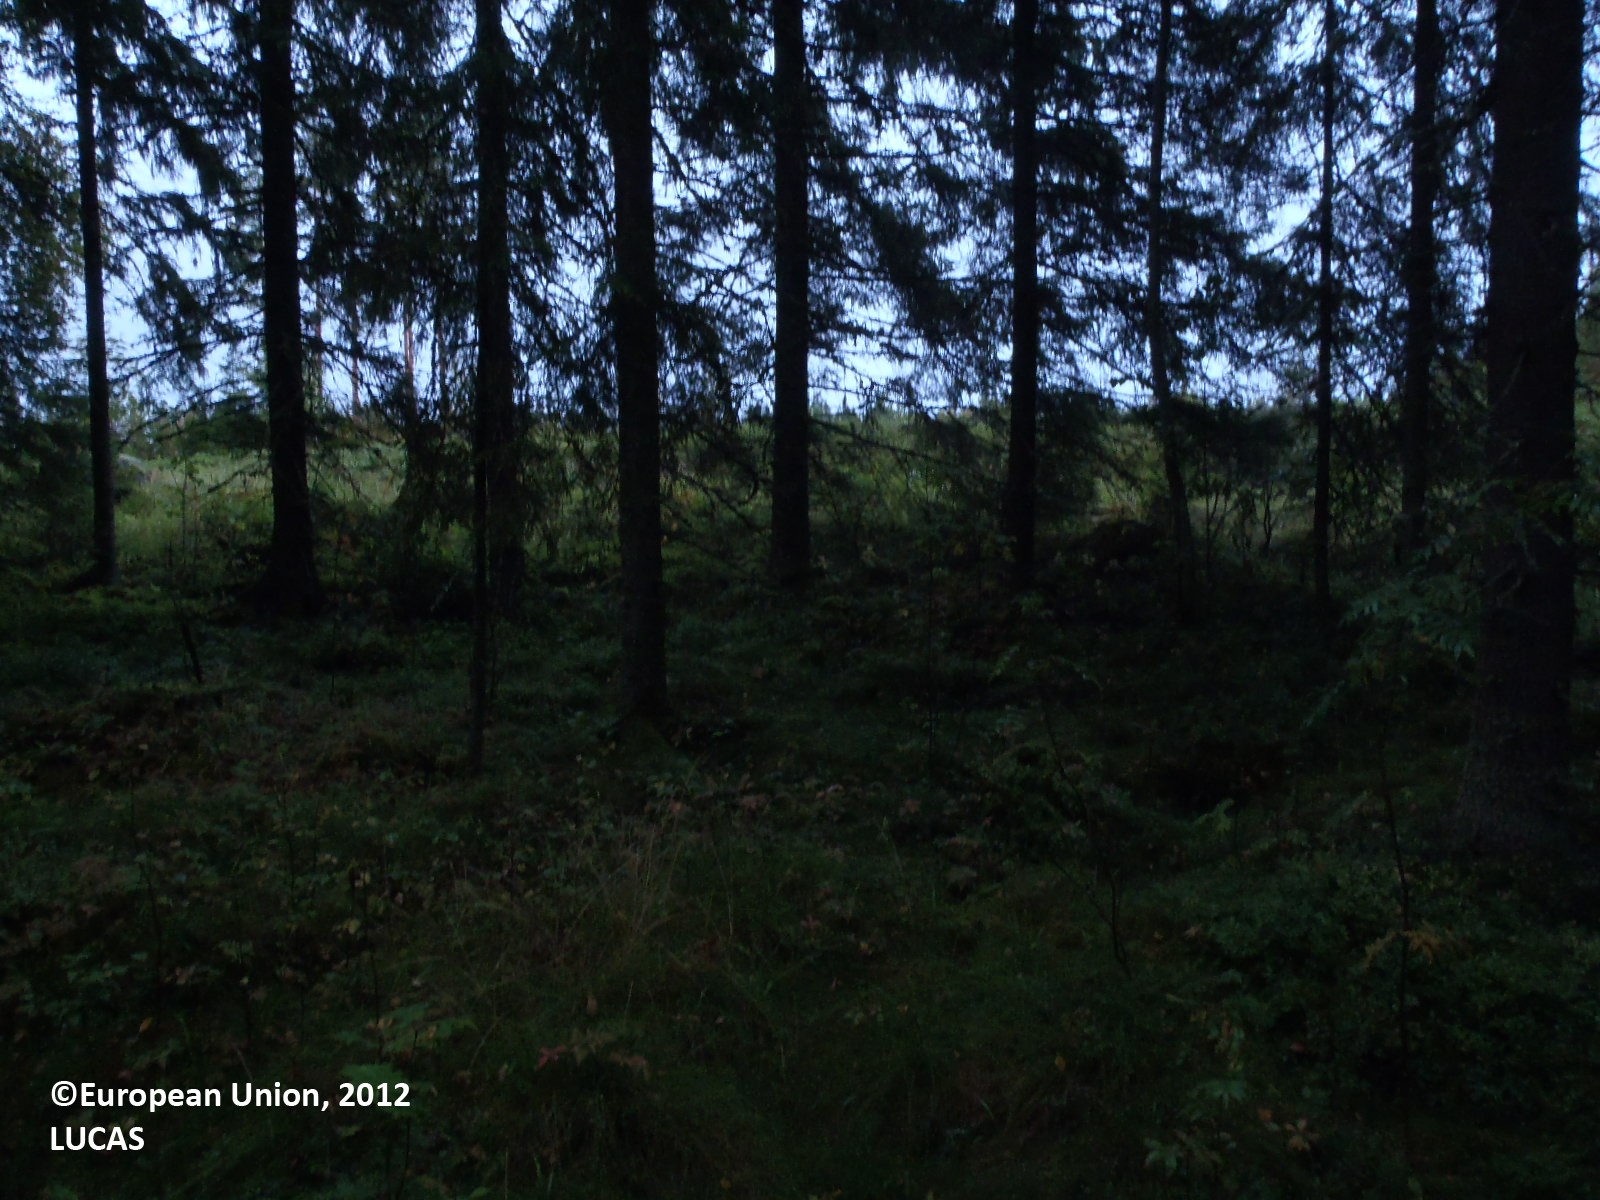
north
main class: Woodland
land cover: Spruce dominated coniferous woodland
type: boreal forest
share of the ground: > 75 %
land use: Forestry
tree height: > 5 m
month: September
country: FI
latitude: 61.7110
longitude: 22.6424
